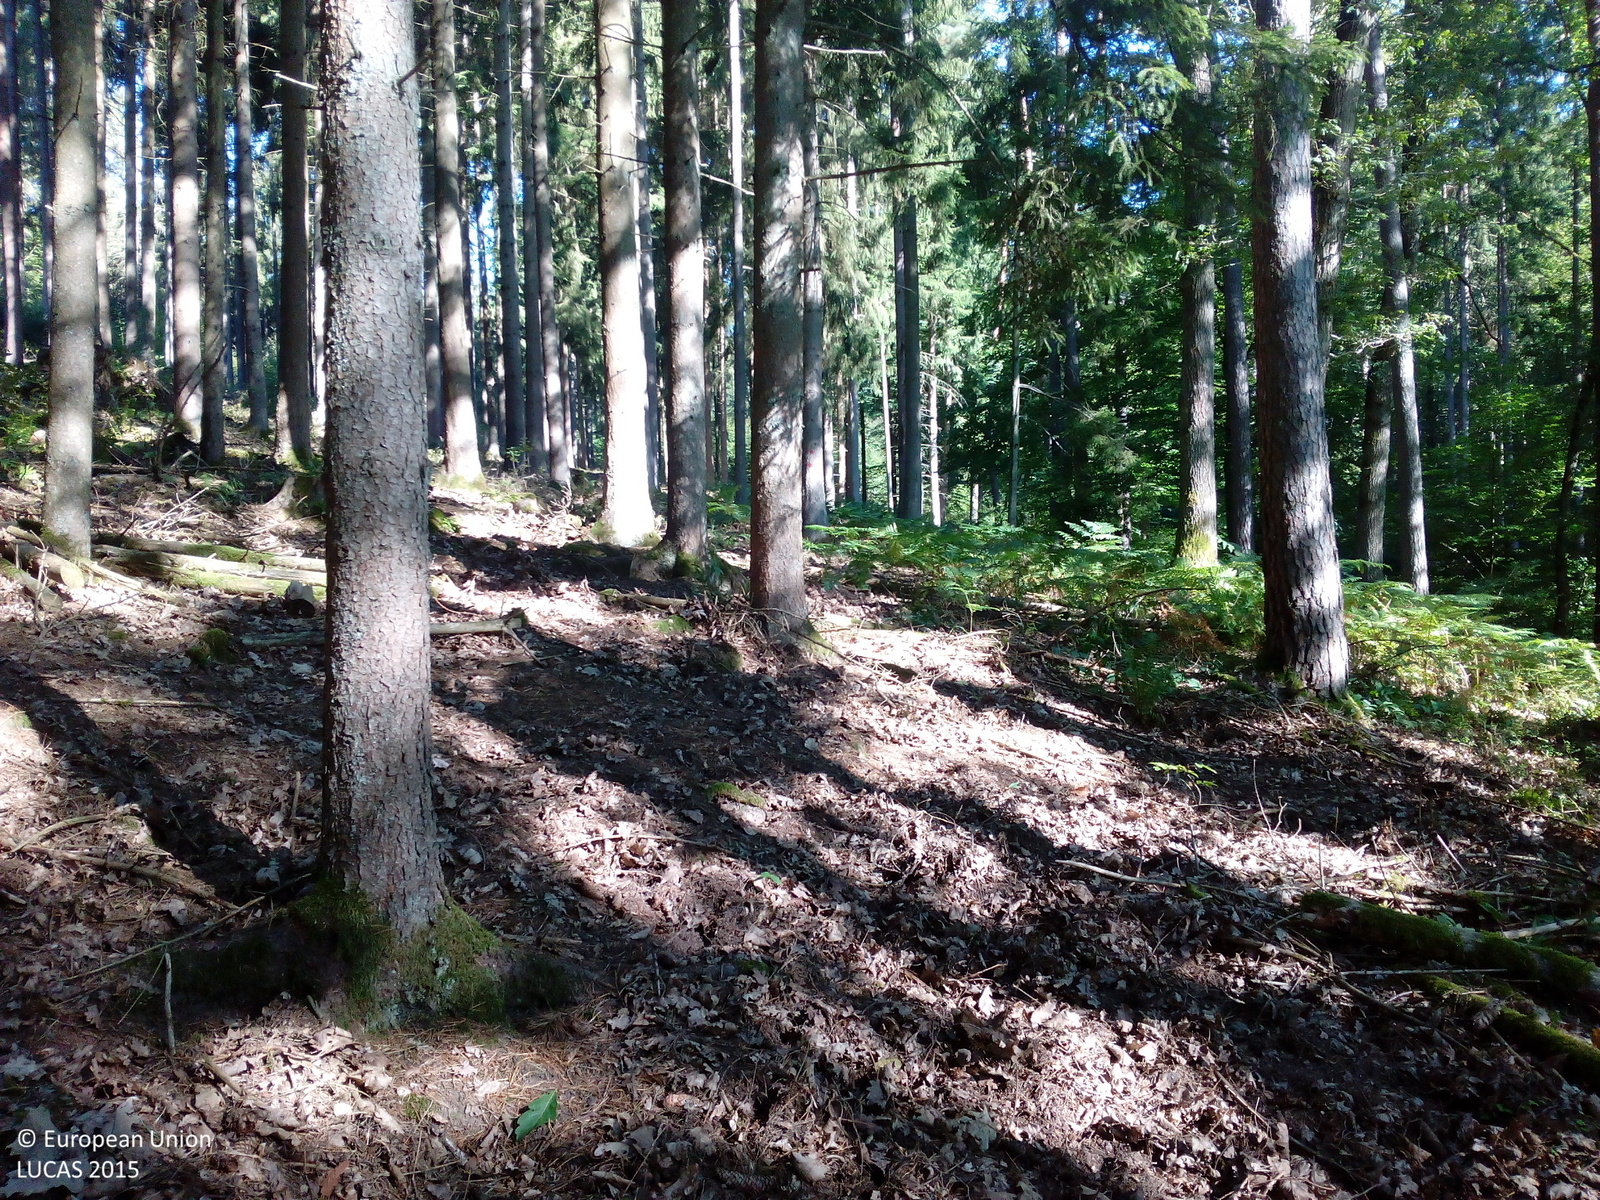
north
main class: Woodland
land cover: Spruce dominated coniferous woodland
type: hemiboreal forest and nemoral coniferous forest and mixed broadleaved-coniferous forest
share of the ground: > 75 %
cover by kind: coniferous forest trees 90 %, unconsolidated bare surface 10 %
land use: Forestry
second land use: Amenities, museums, leisure
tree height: > 5 m
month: September
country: DE
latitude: 49.9137
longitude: 9.5684
